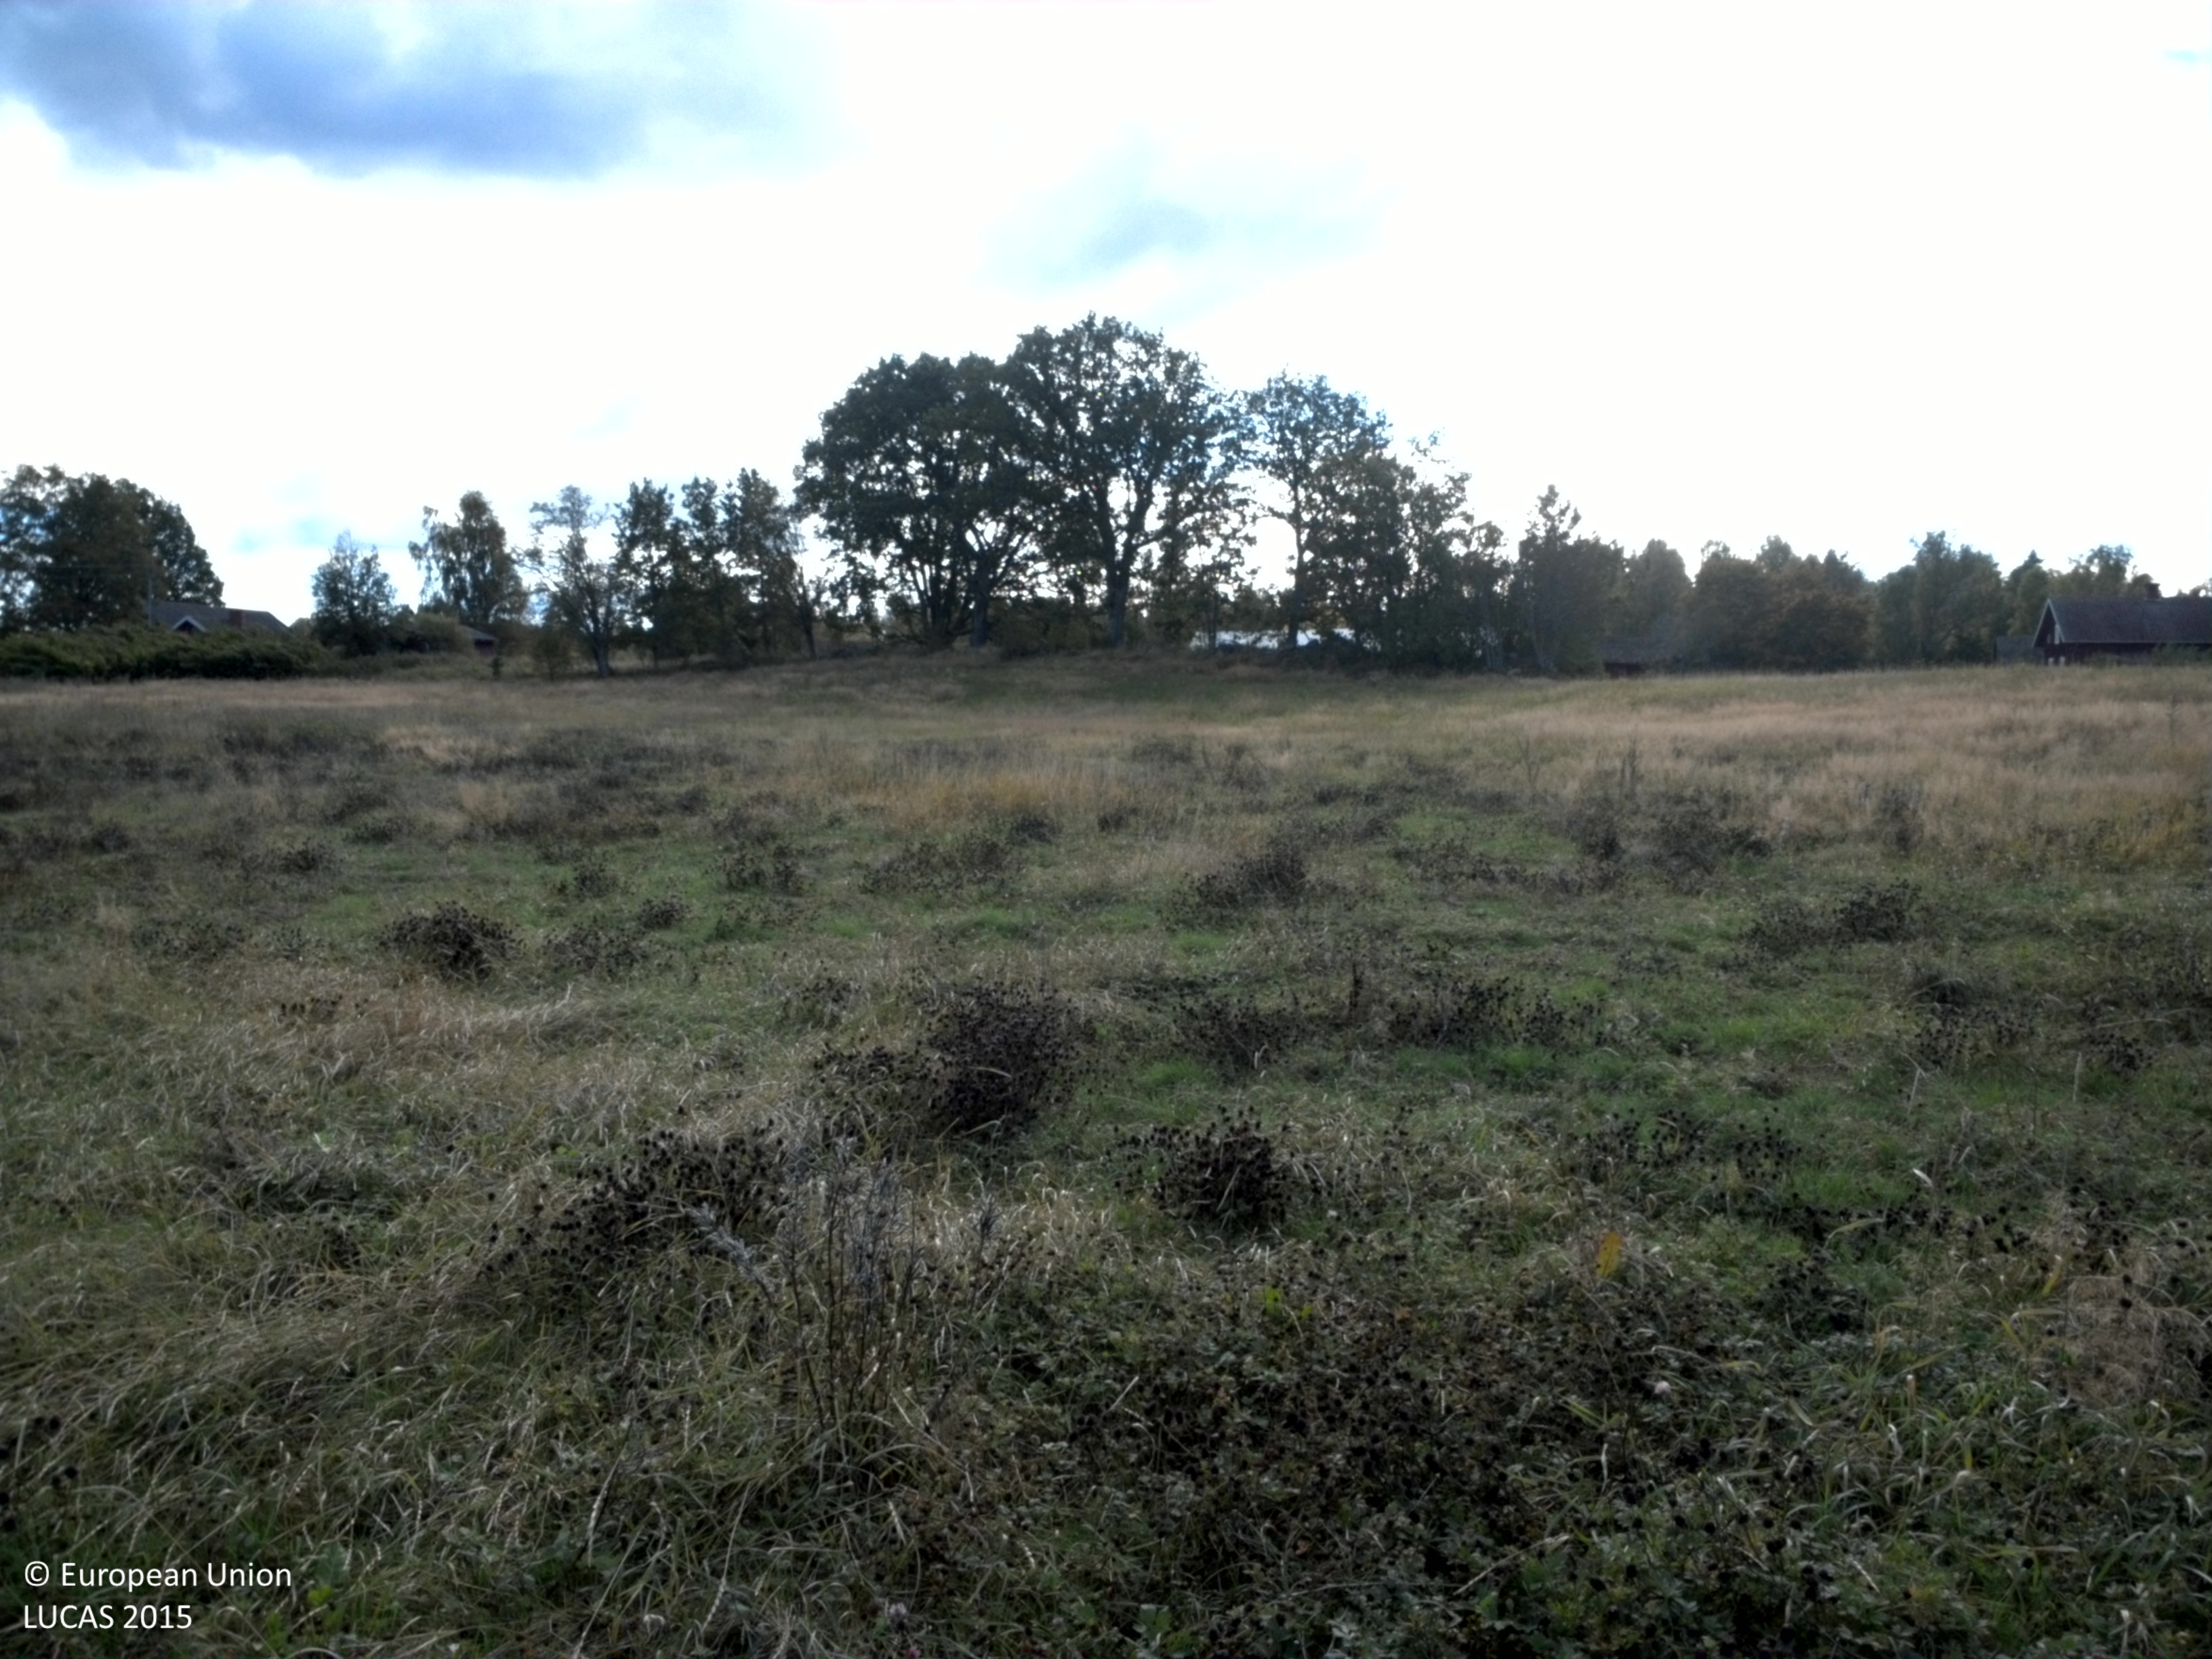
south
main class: Grassland
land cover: Spontaneously vegetated surfaces
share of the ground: > 75 %
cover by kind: herbaceous plants 100 %
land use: Fallow land
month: September
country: SE
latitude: 59.0929
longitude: 14.1289
